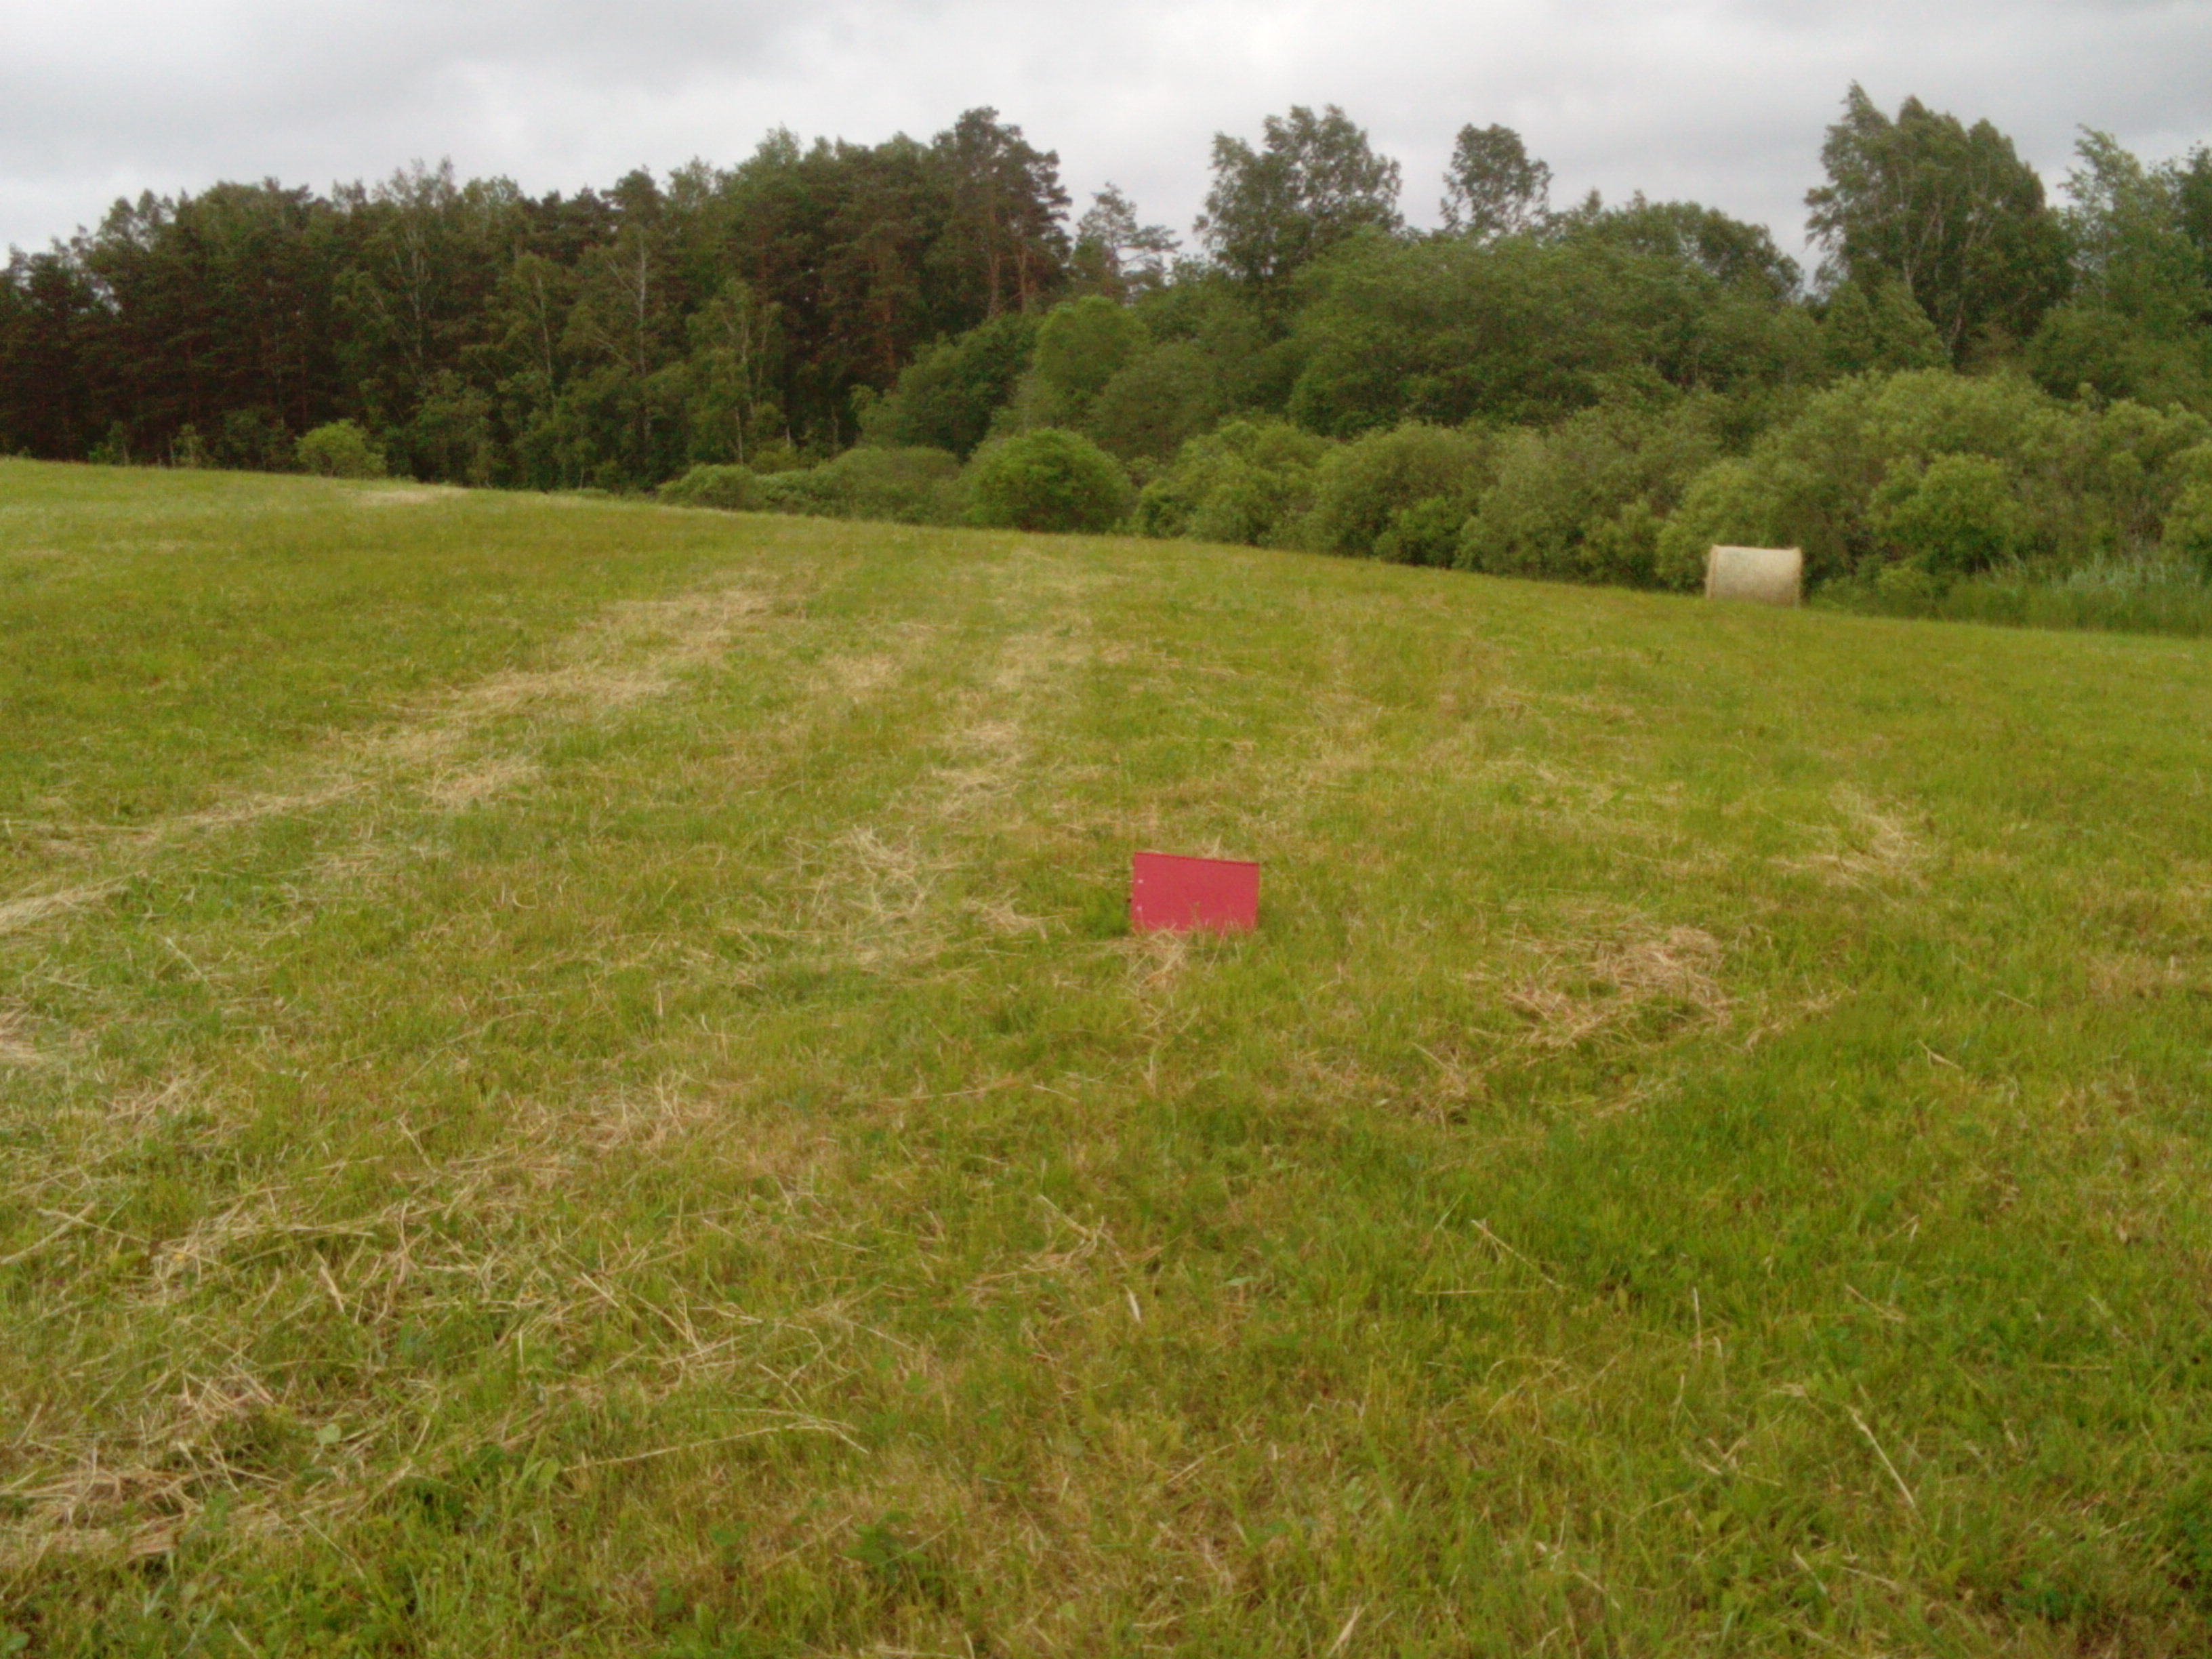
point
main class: Grassland
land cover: Grassland without tree/shrub cover
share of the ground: > 75 %
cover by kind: herbaceous plants 100 %
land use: Agriculture (excluding fallow land and kitchen gardens)
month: June
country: LV
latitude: 56.8419
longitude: 21.9986
